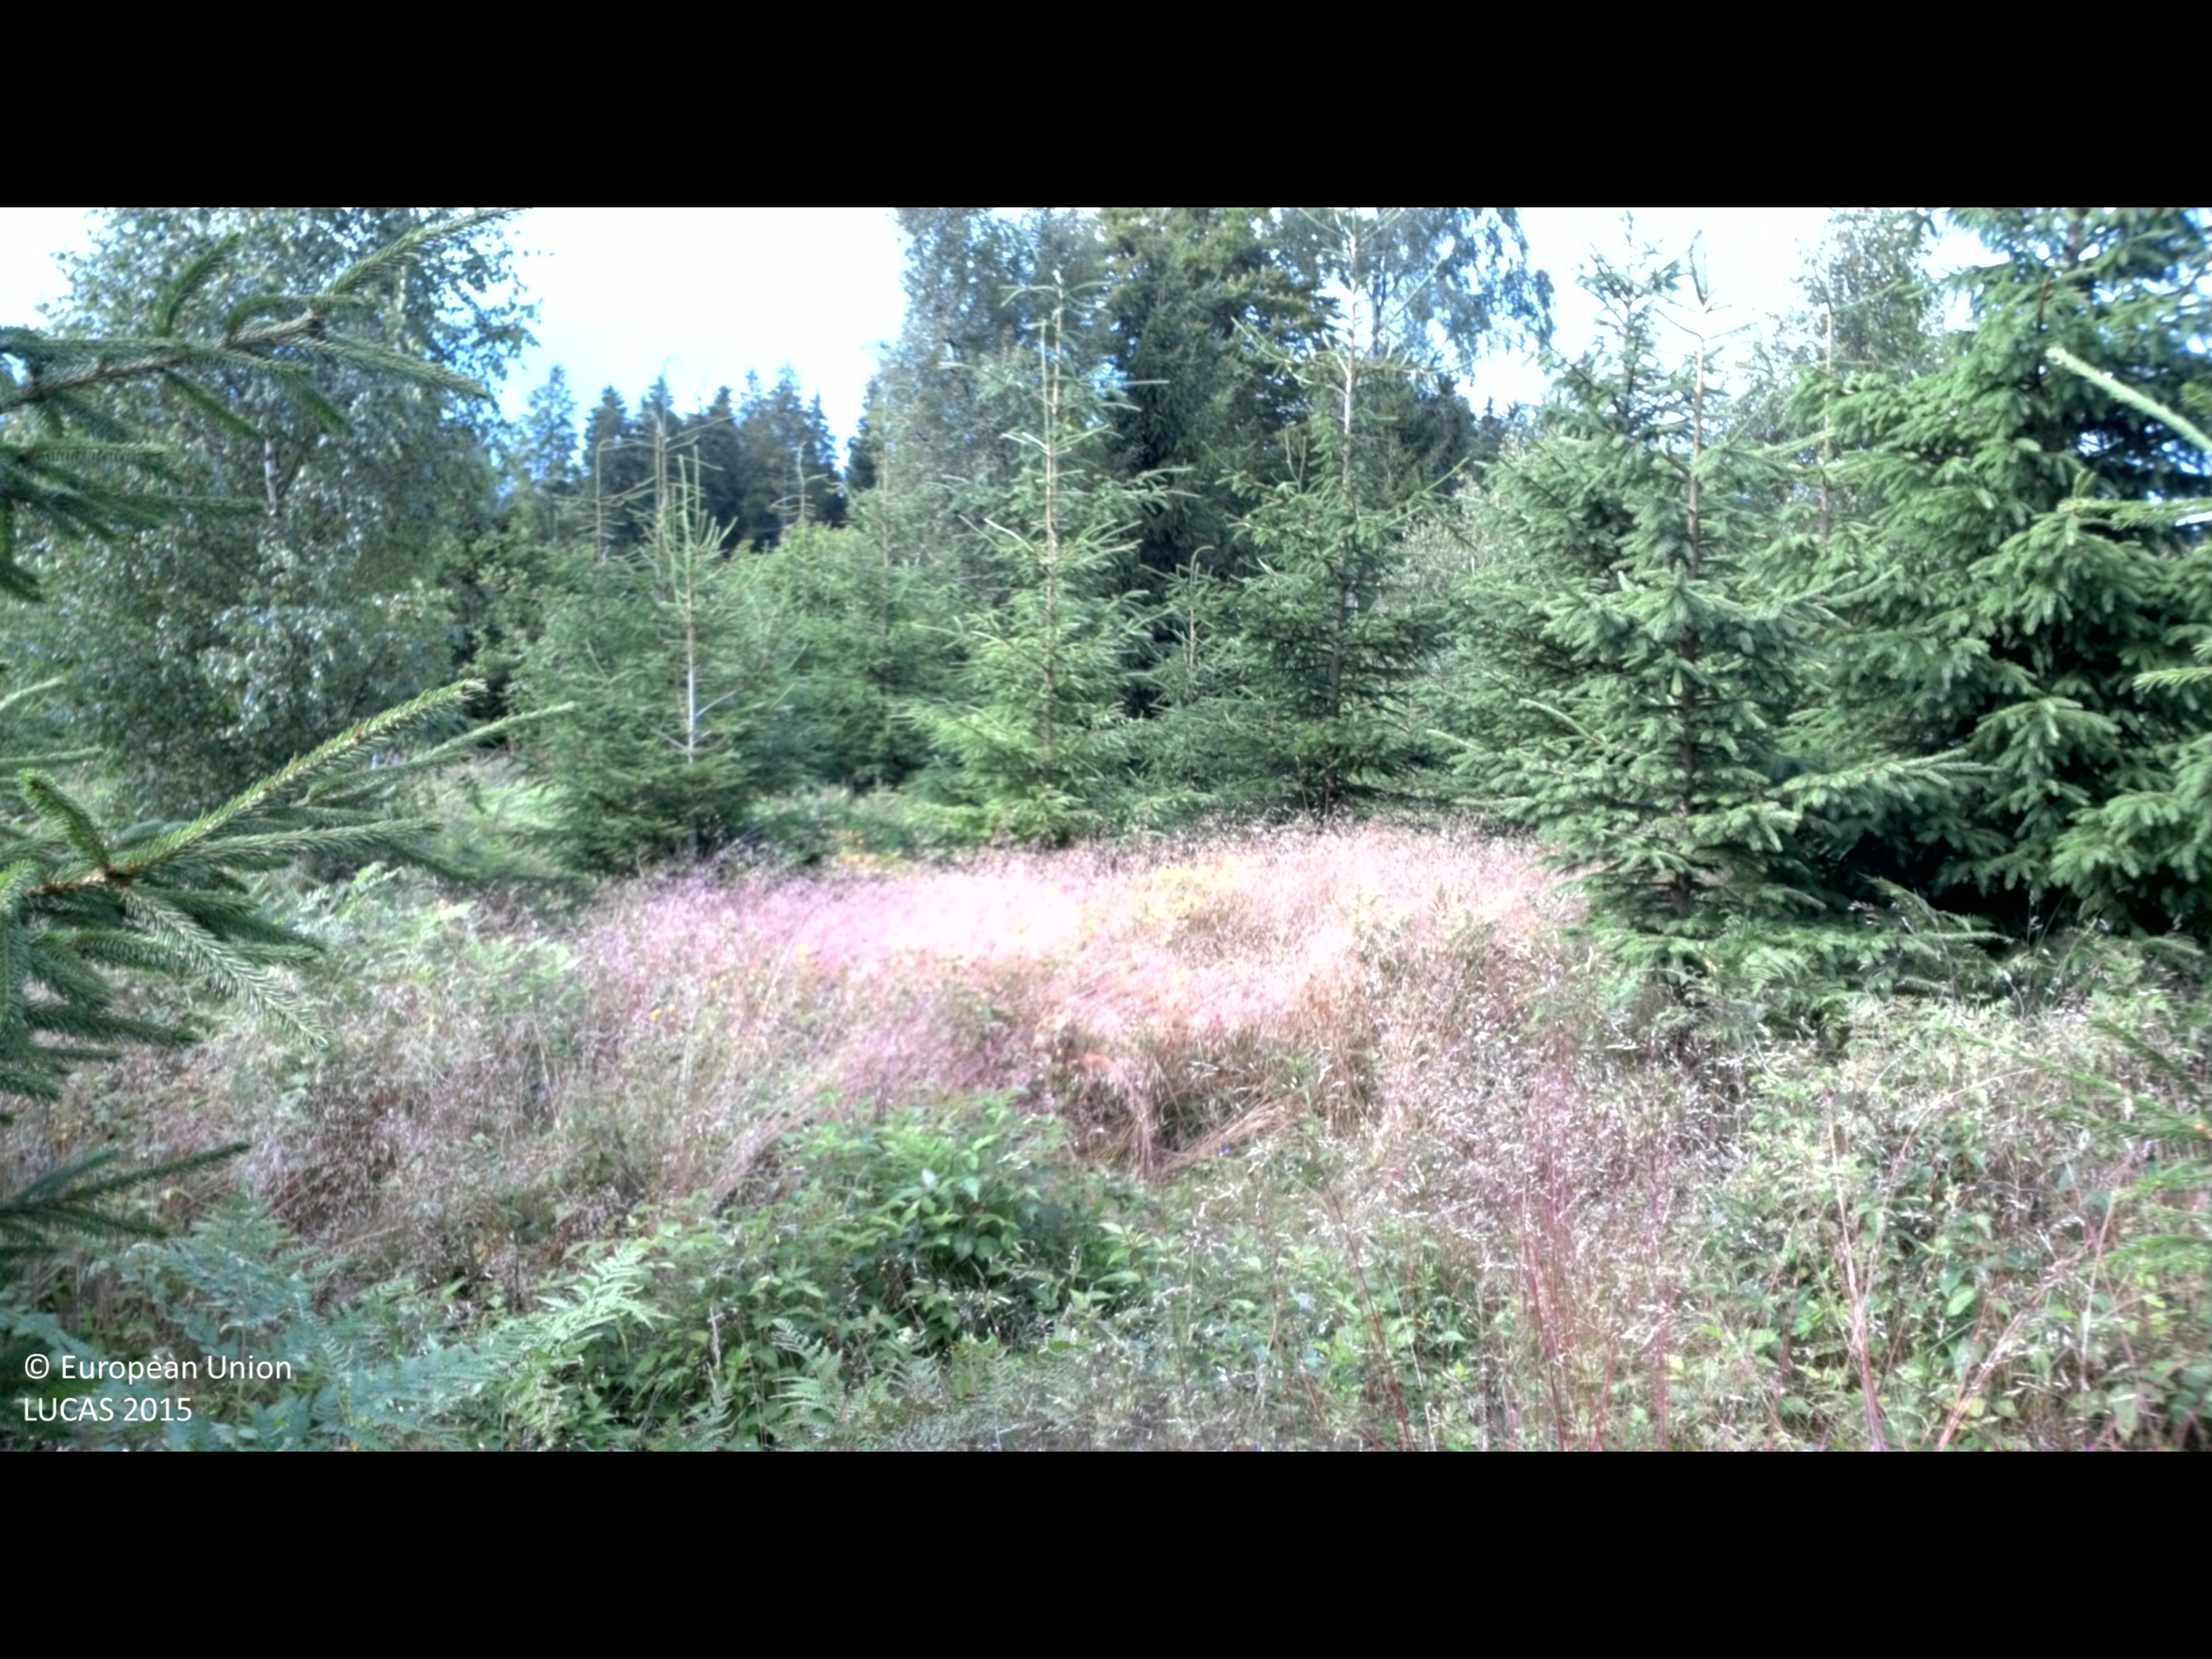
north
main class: Woodland
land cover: Spruce dominated coniferous woodland
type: boreal forest
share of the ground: 50 - 75 %
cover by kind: coniferous forest trees 55 %, shrubs 25 %, herbaceous plants 20 %
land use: Forestry
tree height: < 5 m
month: August
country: SE
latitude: 56.3735
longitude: 14.1262
